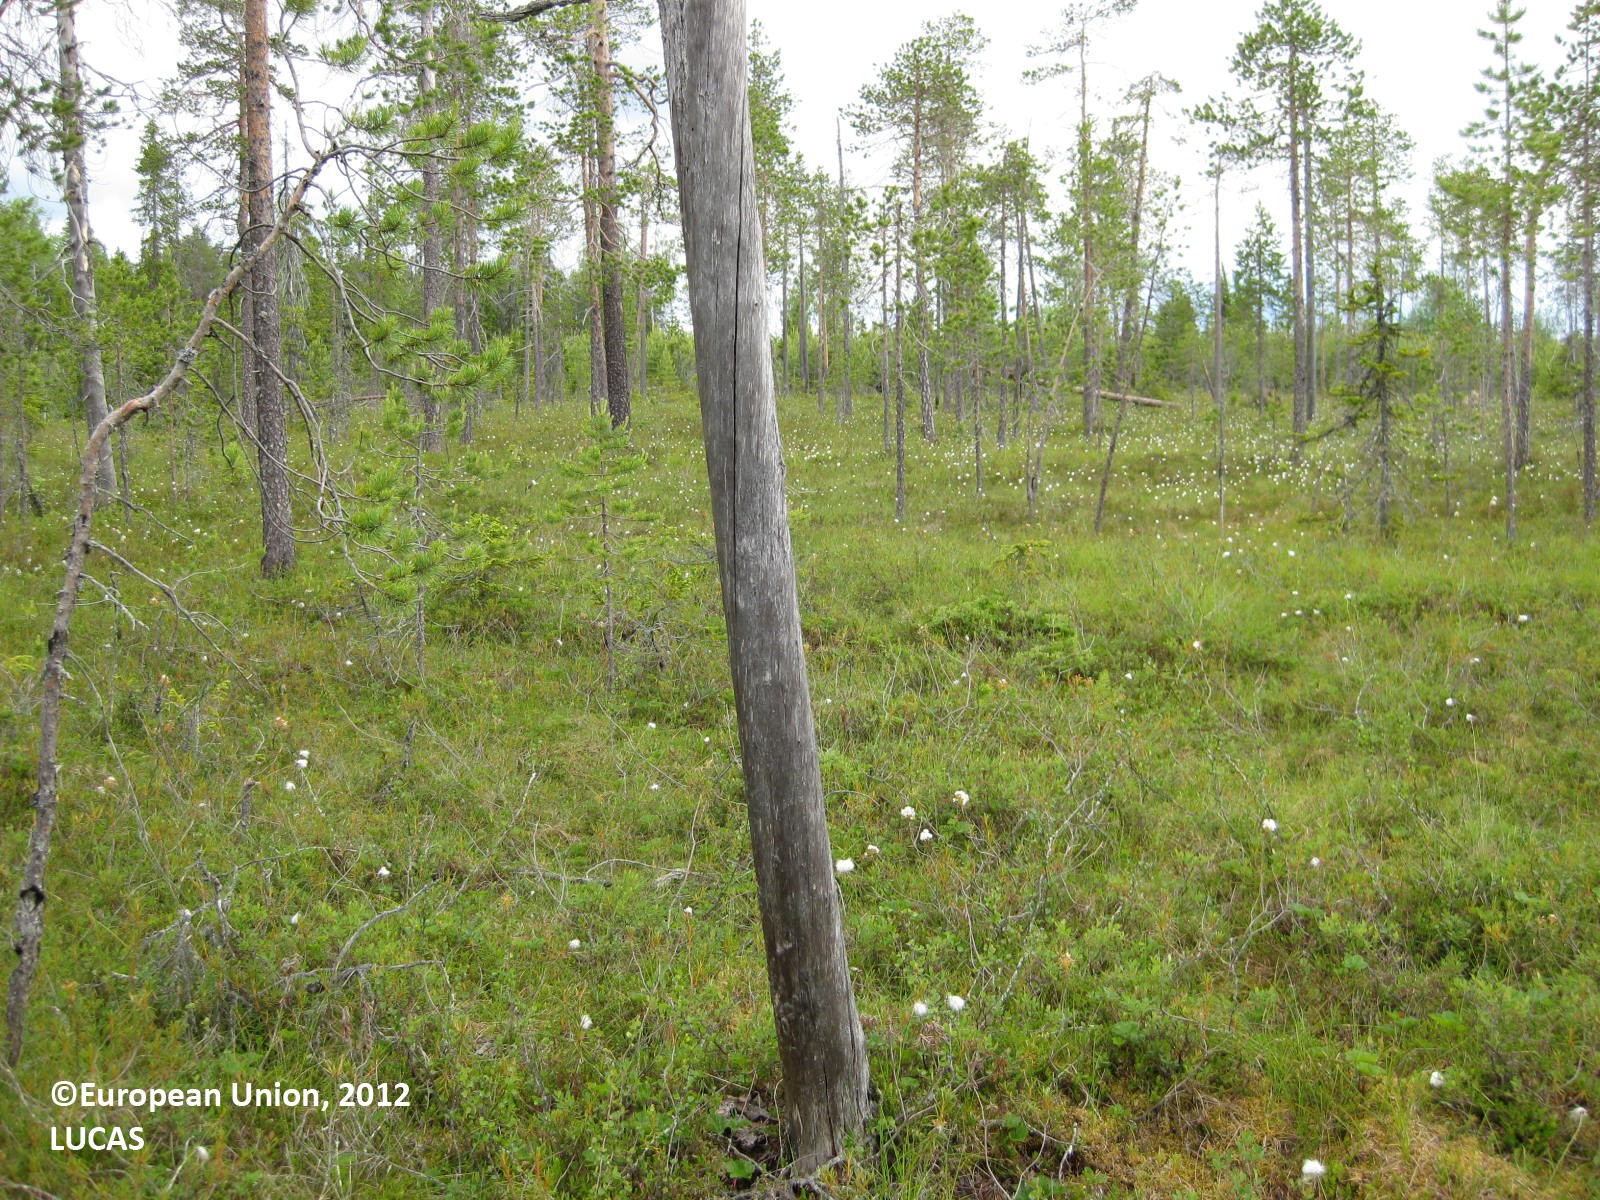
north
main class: Woodland
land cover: Pine dominated coniferous woodland
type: mire and swamp forests
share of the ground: 25 - 50 %
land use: Semi-natural and natural areas not in use
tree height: > 5 m
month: July
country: FI
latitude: 65.5471
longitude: 29.2173
